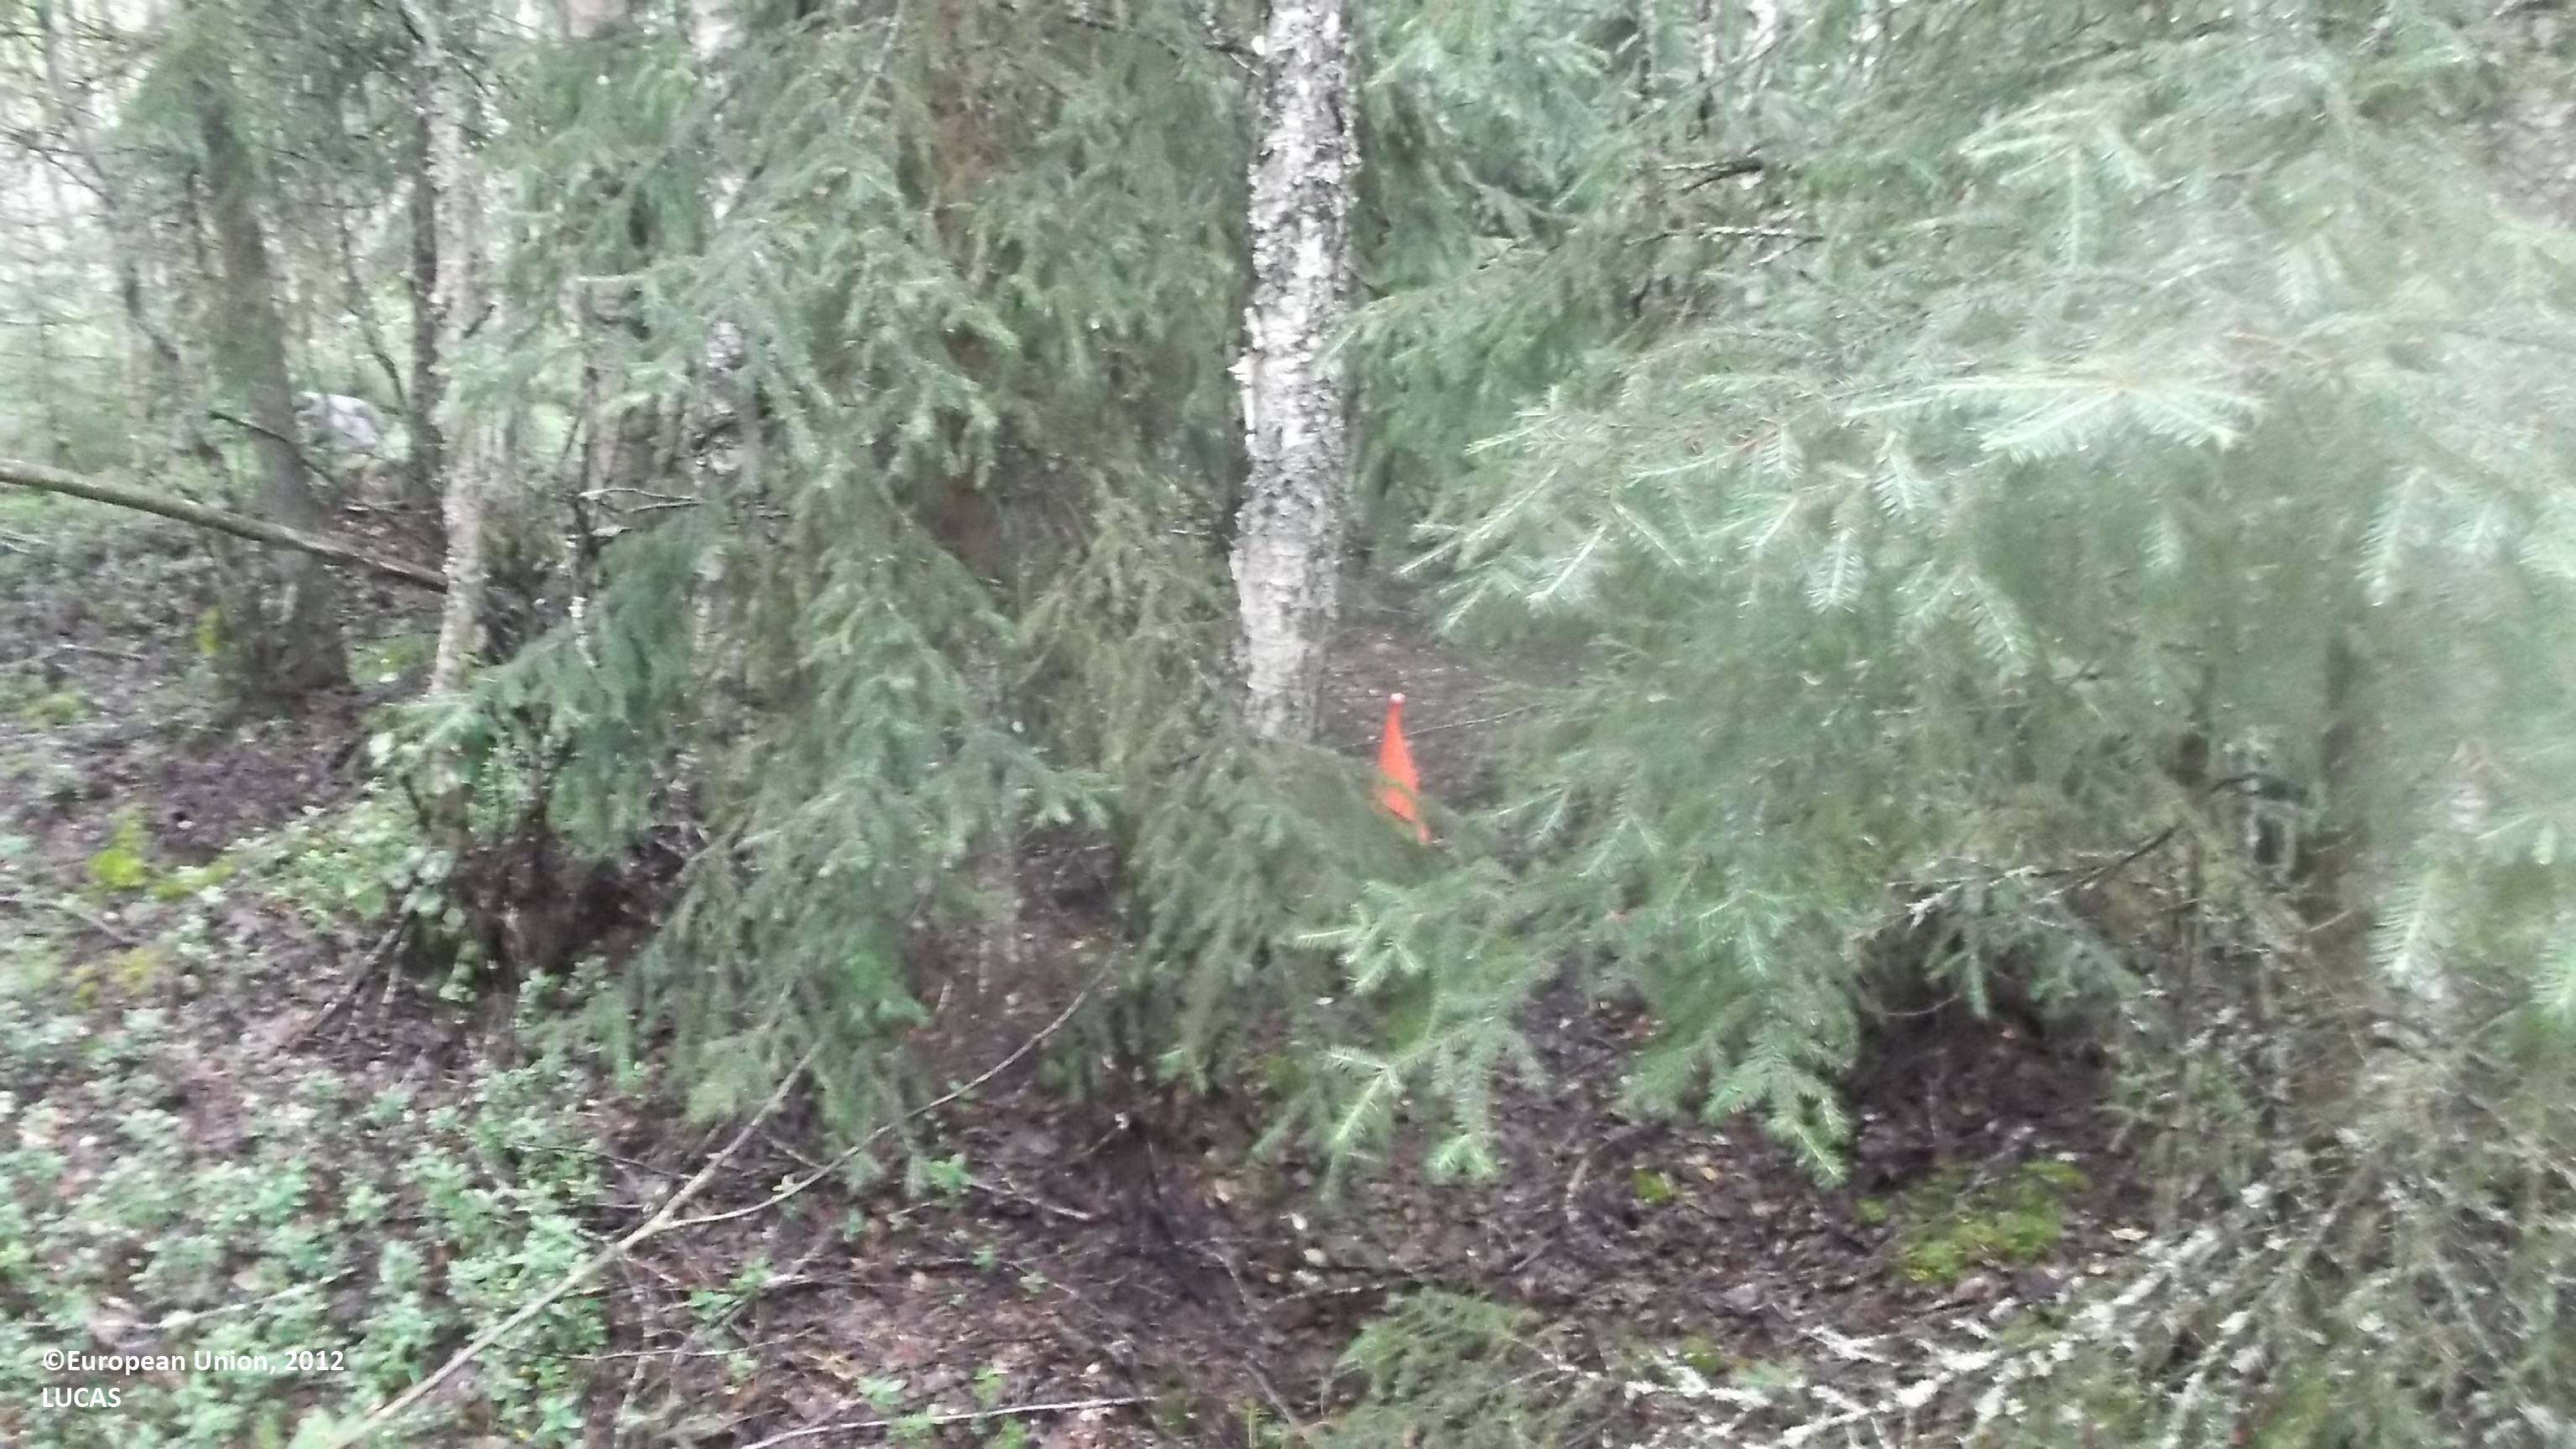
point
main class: Woodland
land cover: Other mixed woodland
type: boreal forest
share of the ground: > 75 %
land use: Forestry
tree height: > 5 m
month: August
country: FI
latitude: 63.8010
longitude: 23.2718
